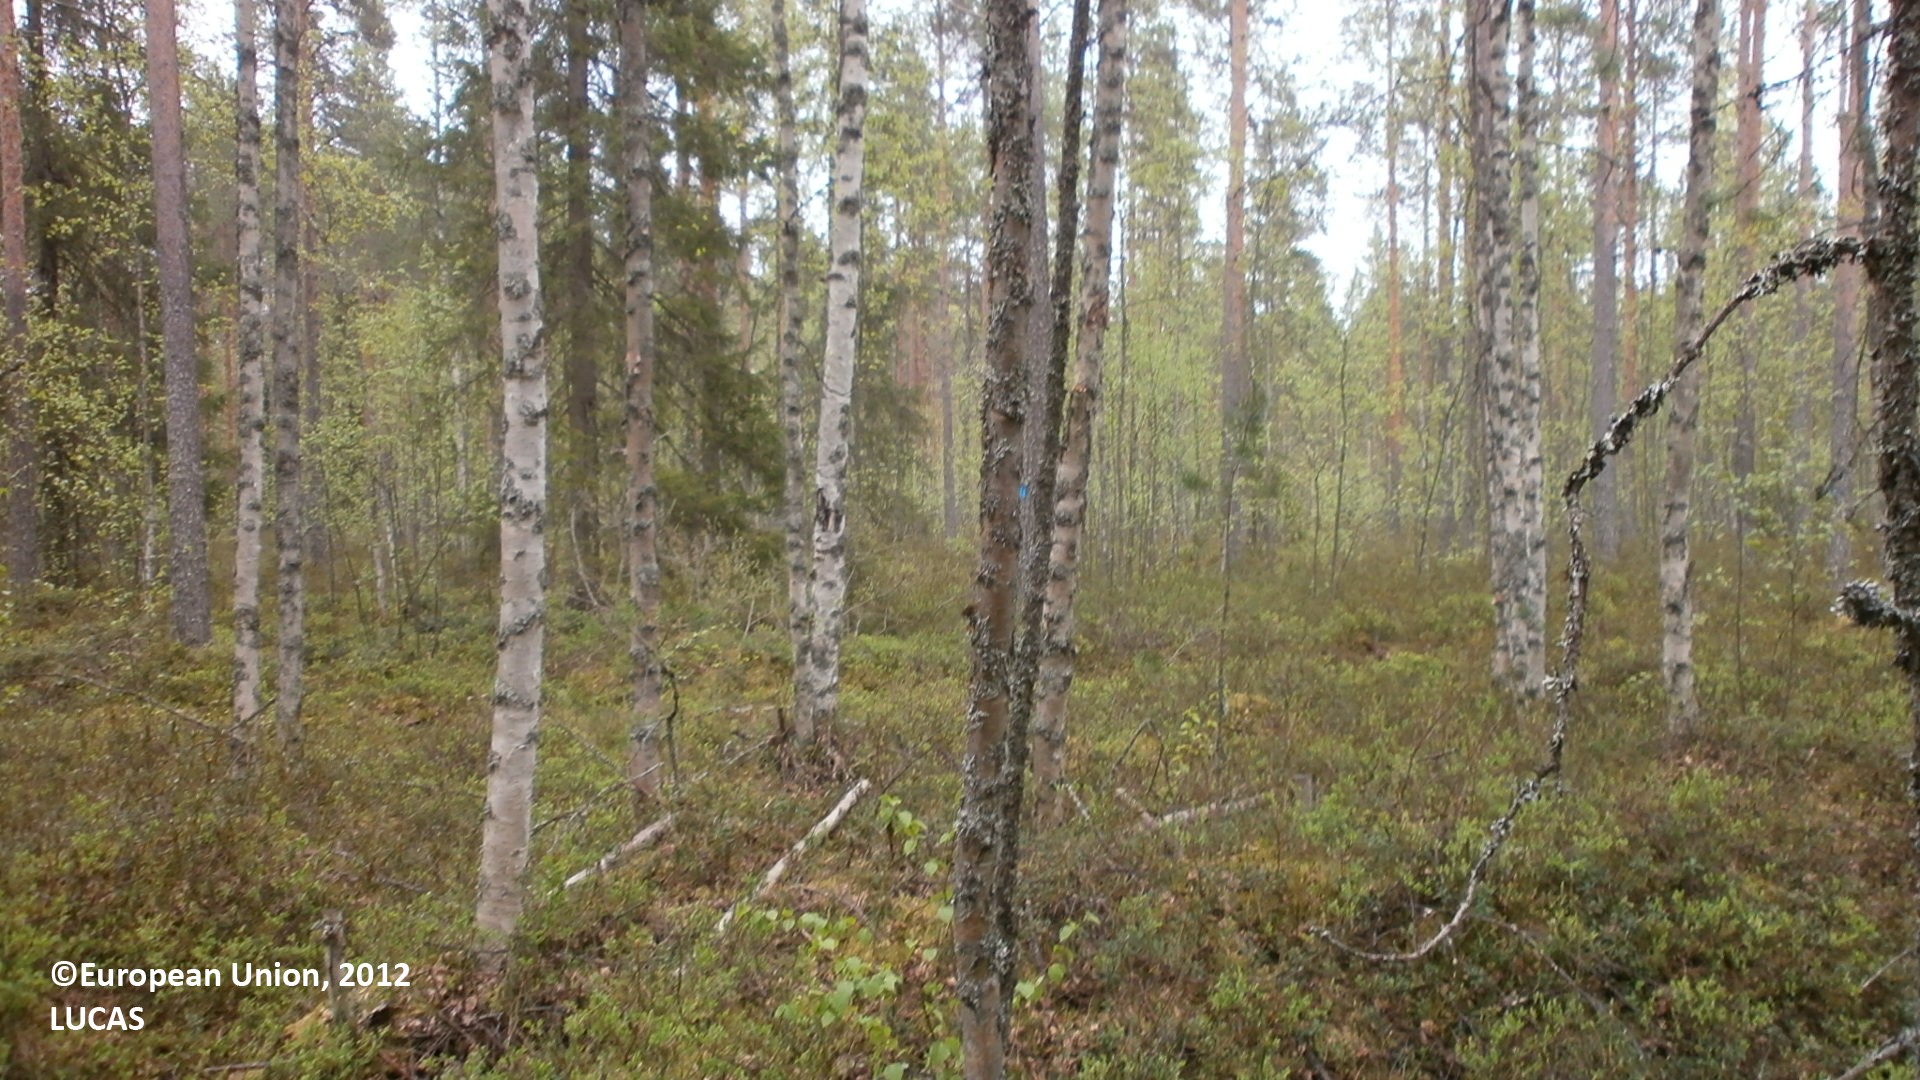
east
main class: Woodland
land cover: Pine dominated mixed woodland
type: hemiboreal forest and nemoral coniferous forest and mixed broadleaved-coniferous forest
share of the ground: 50 - 75 %
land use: Forestry
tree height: > 5 m
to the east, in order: Pine dominated mixed woodland; Other mixed woodland; Ditches and canals; Other mixed woodland; Tracks; Other mixed woodland; Ditches and canals; Other mixed woodland; Ditches and canals; Pine dominated mixed woodland; Tracks; Pine dominated mixed woodland; Ditches and canals; Pine dominated mixed woodland; Ditches and canals; Pine dominated mixed woodland; Other mixed woodland; Ditches and canals; Other mixed woodland; Pine dominated mixed woodland
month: June
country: FI
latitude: 64.2953
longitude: 25.8678
